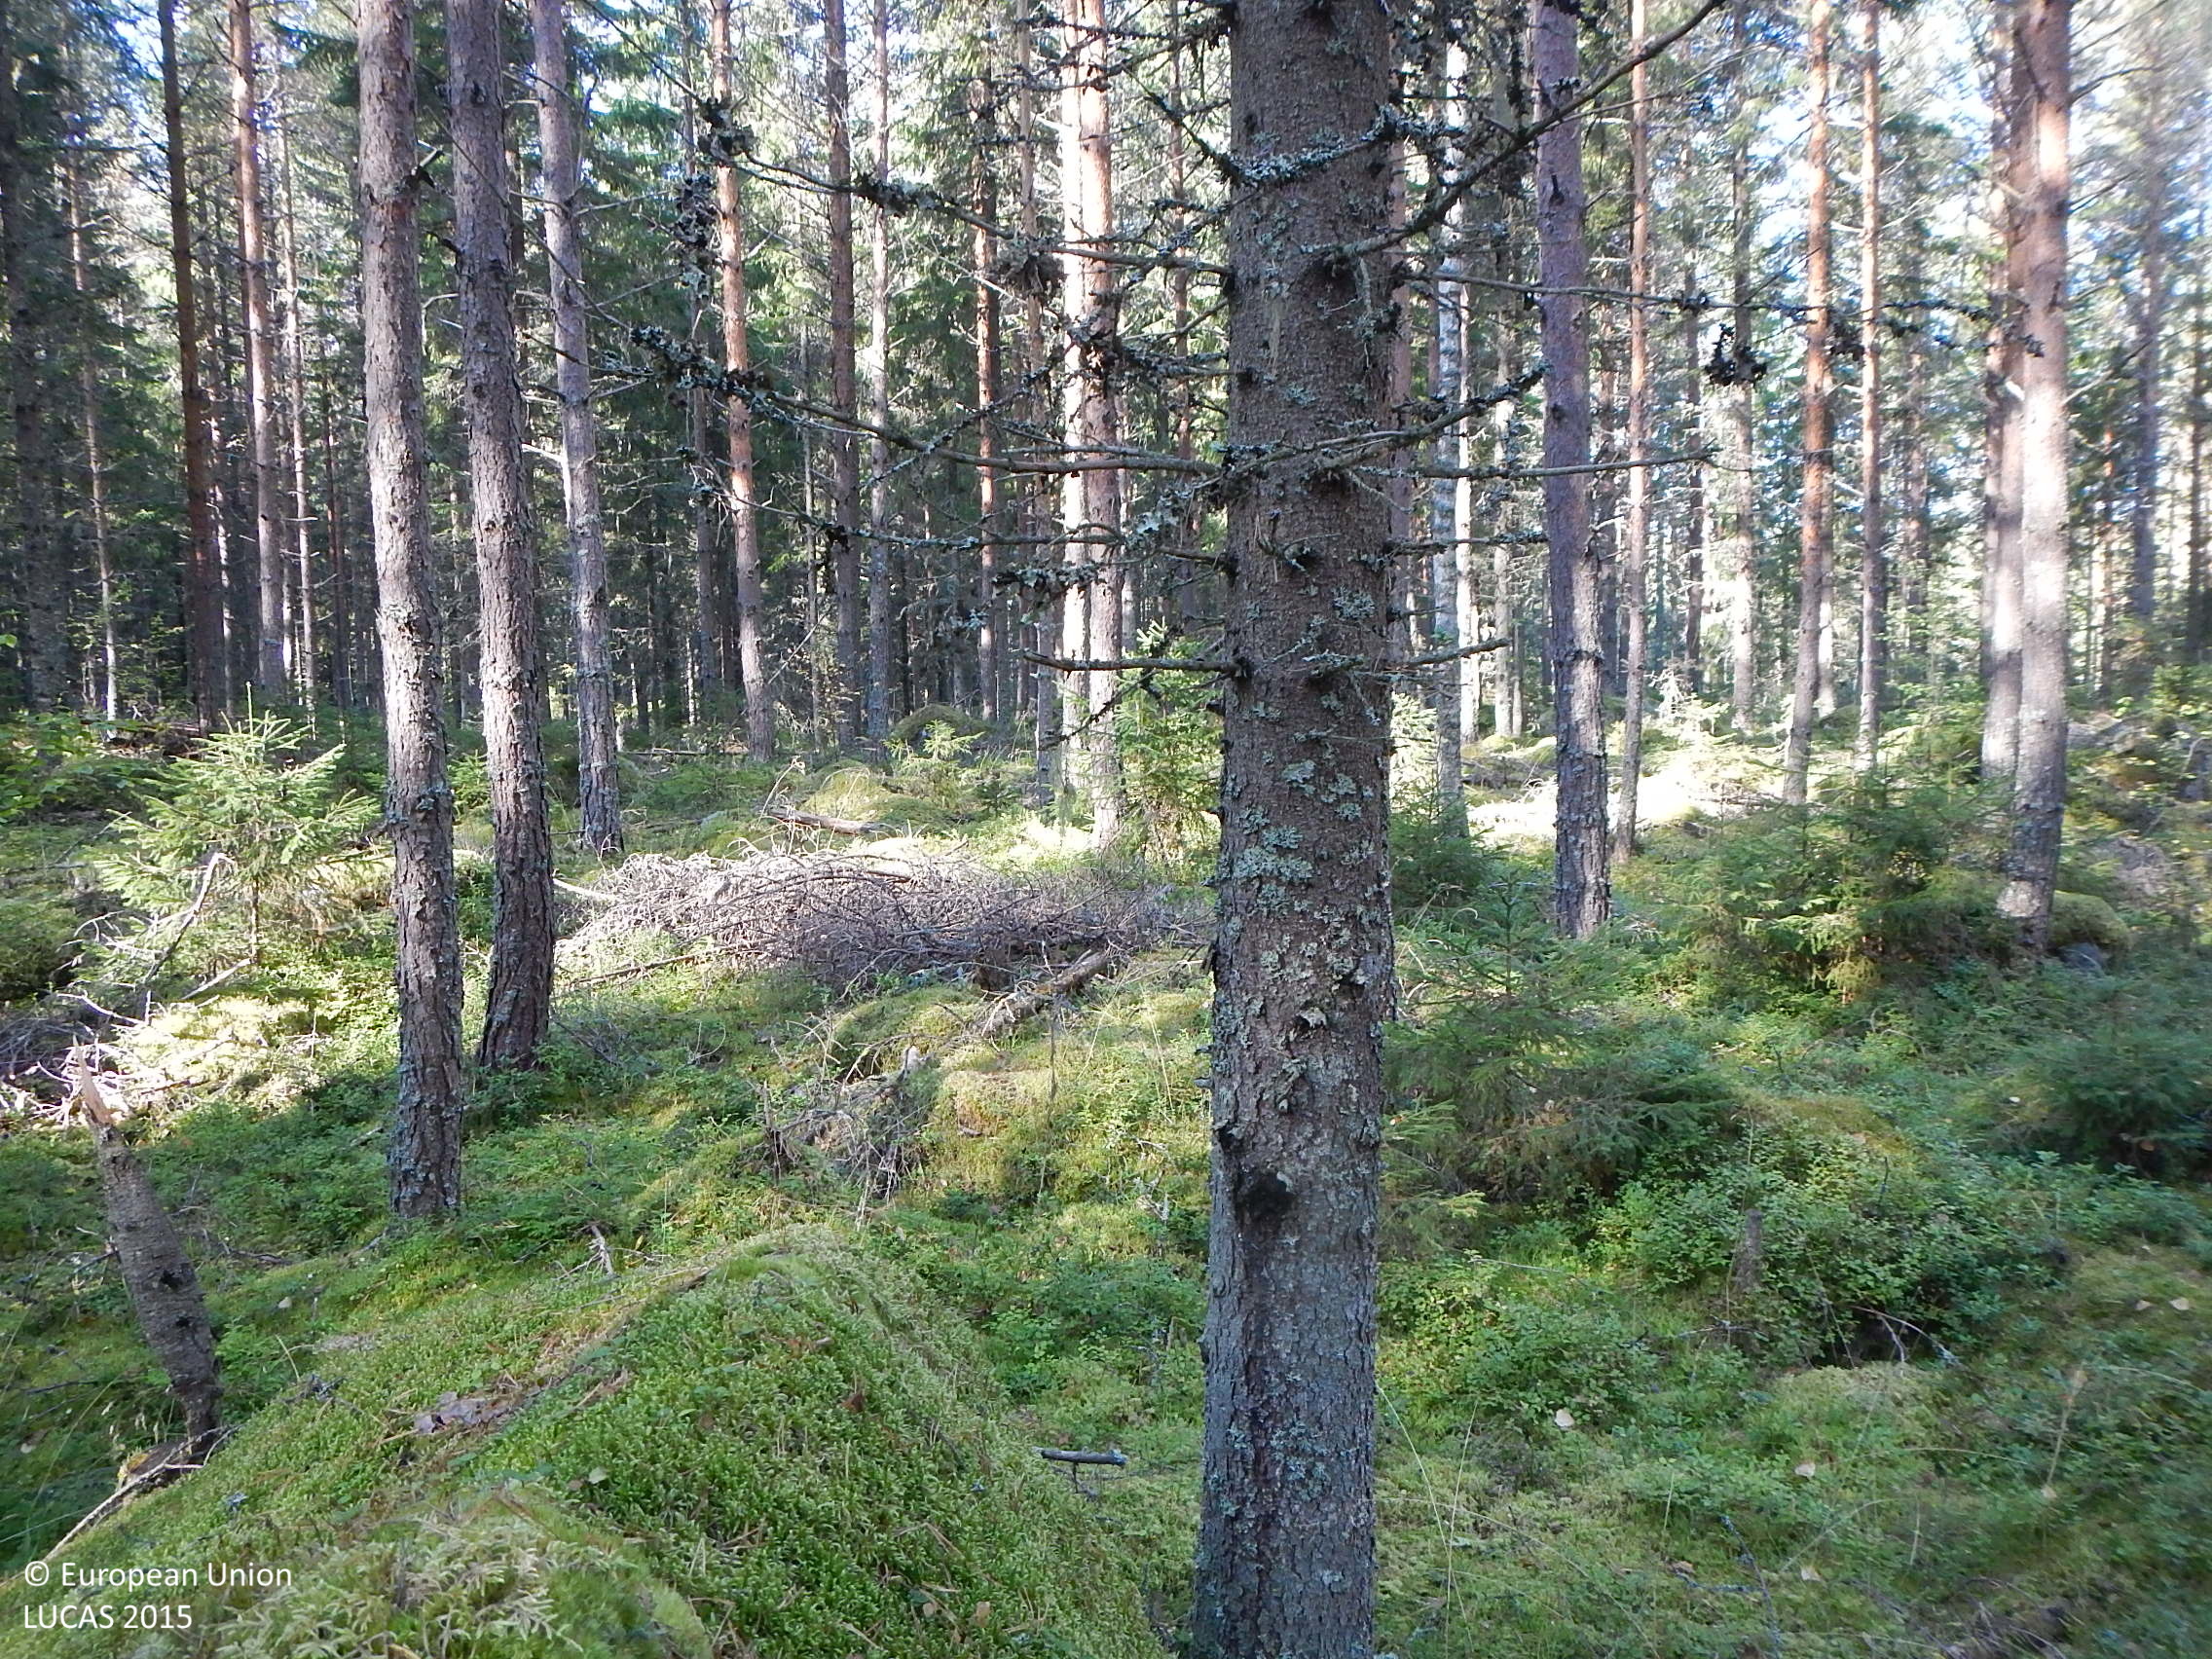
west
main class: Woodland
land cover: Pine dominated coniferous woodland
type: boreal forest
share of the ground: > 75 %
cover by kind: coniferous forest trees 75 %, lichens and mosses 25 %
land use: Forestry
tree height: > 5 m
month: September
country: FI
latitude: 61.6250
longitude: 22.1485
